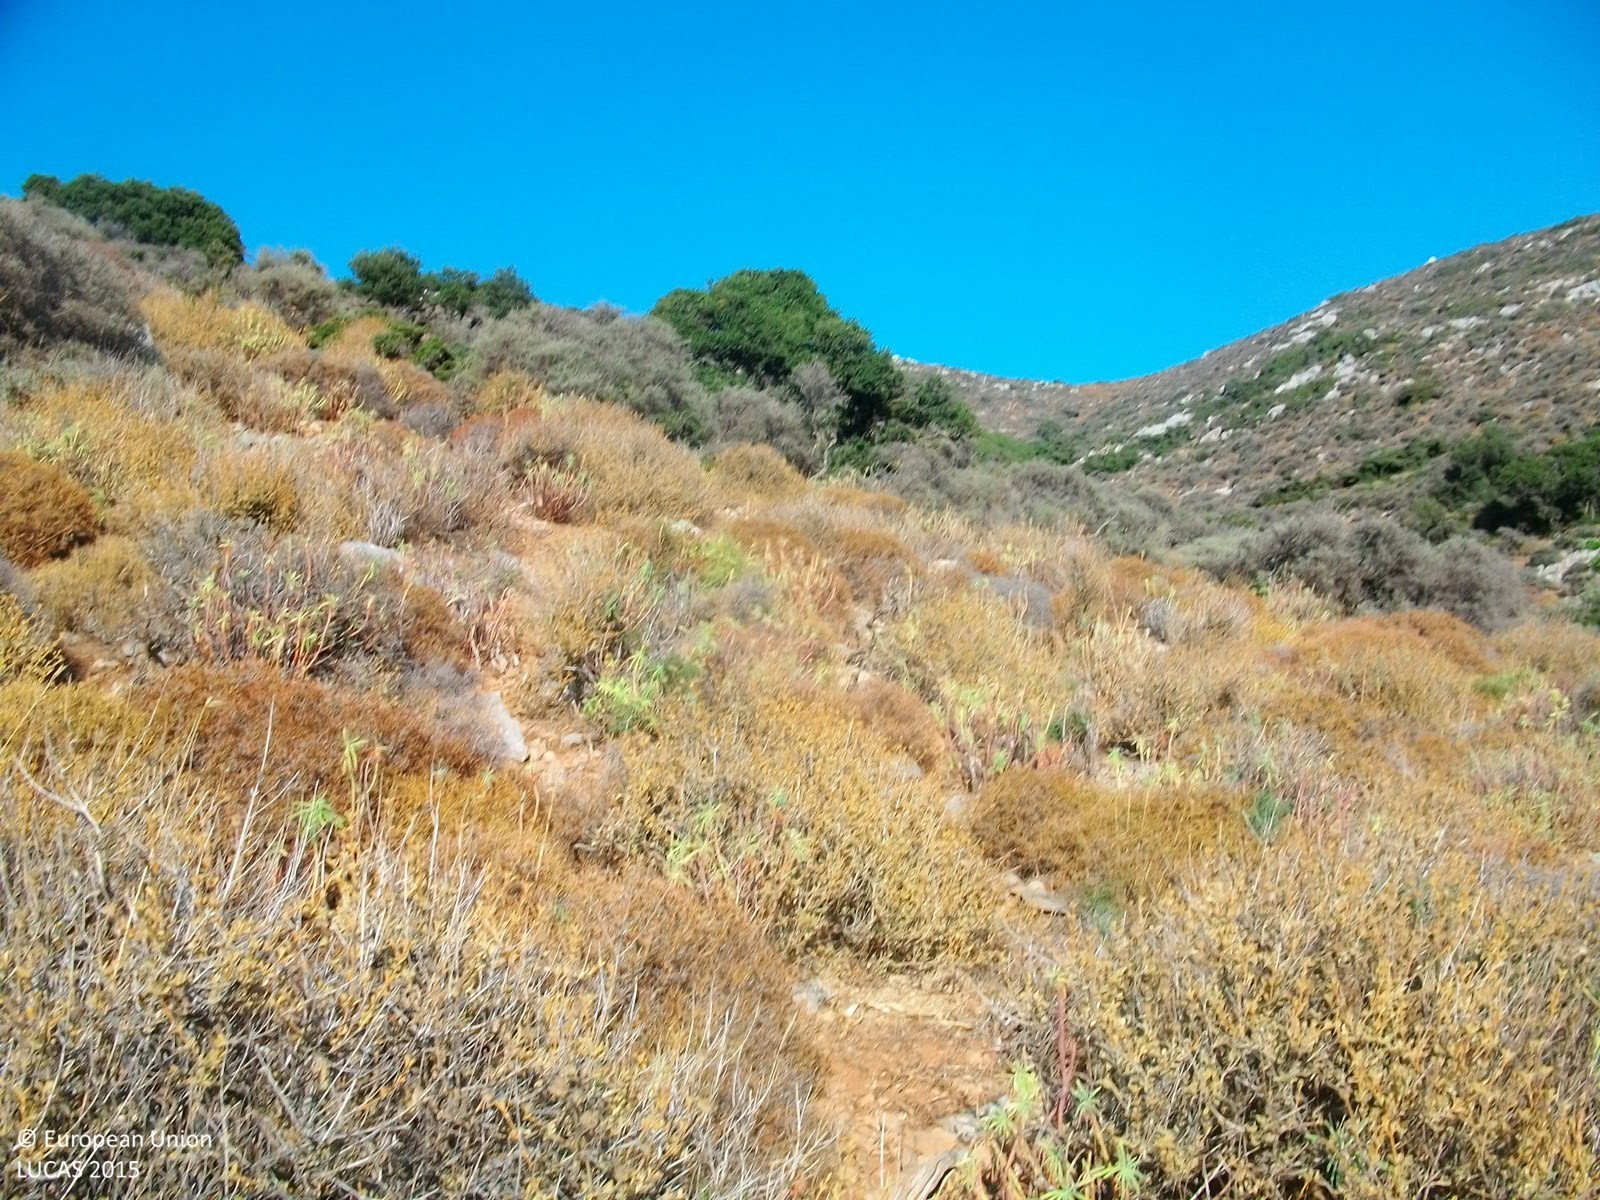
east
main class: Shrubland
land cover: Shrubland without tree cover
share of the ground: > 75 %
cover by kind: shrubs 90 %, consolidated bare surface 10 %
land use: Semi-natural and natural areas not in use
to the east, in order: Shrubland without tree cover; Shrubland with sparse tree cover; Rock outcrops; Shrubland without tree cover
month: August
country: GR
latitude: 35.2858
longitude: 25.6221
